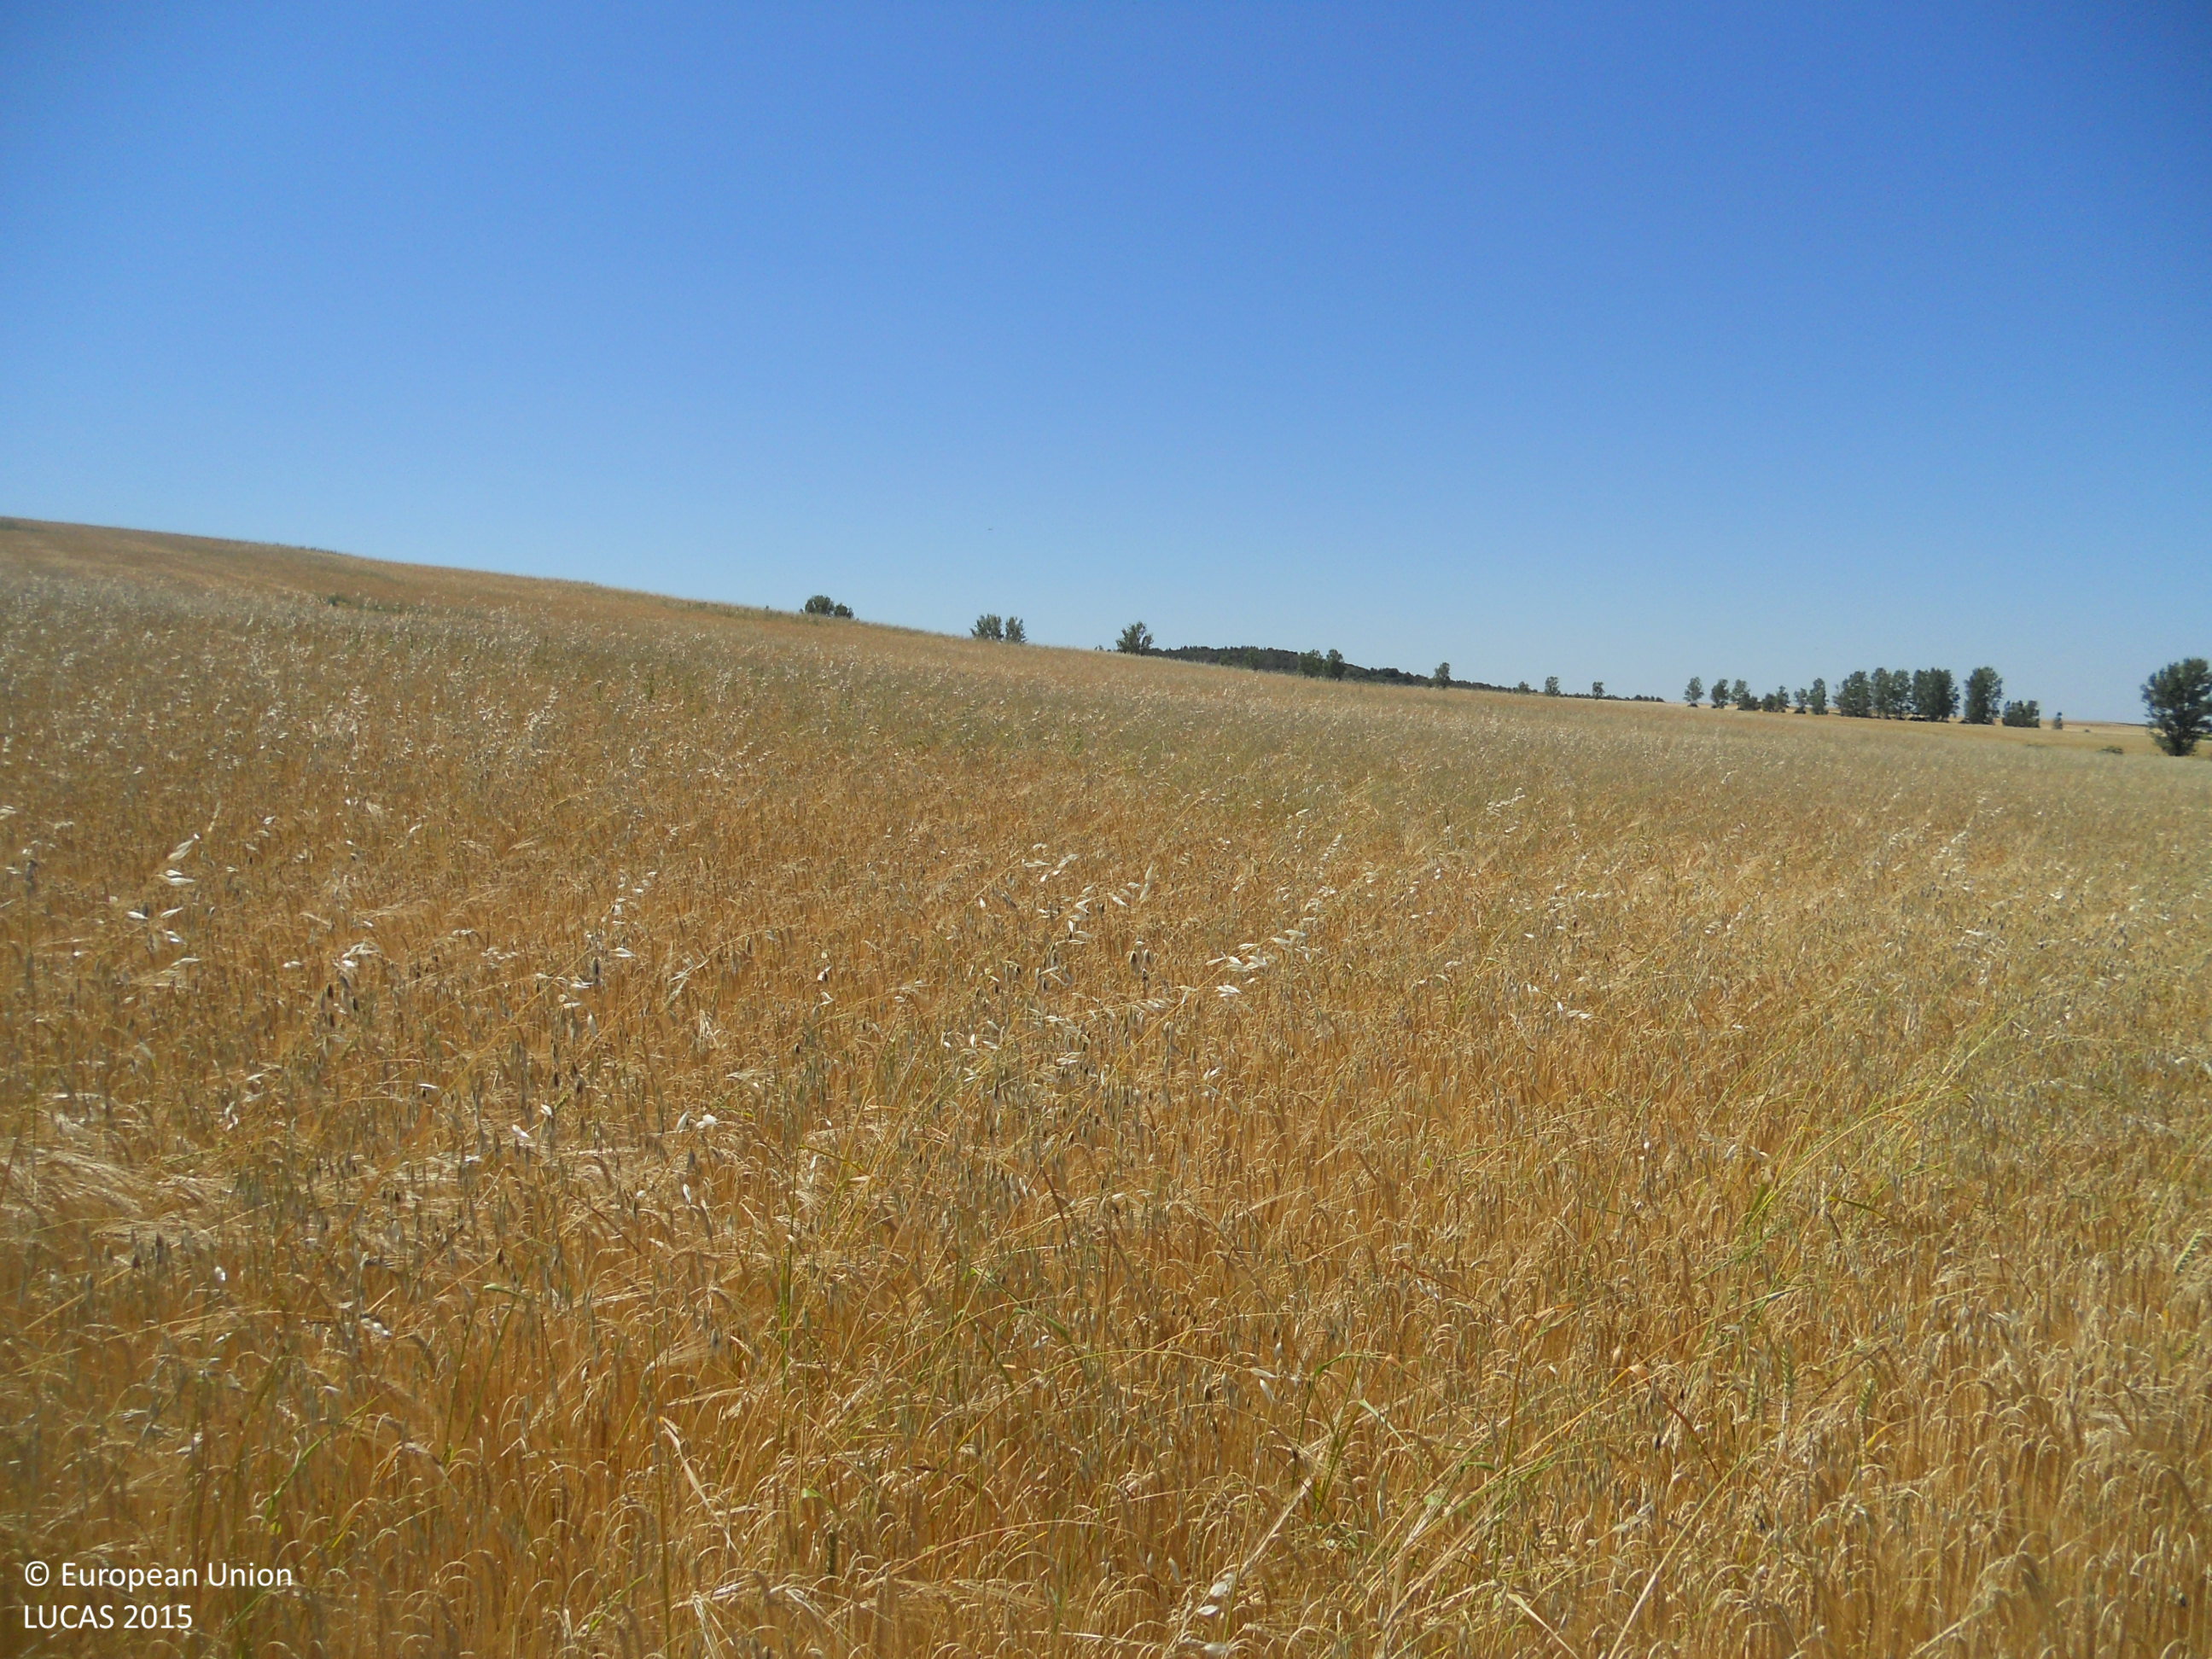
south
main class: Cropland
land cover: Barley
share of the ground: > 75 %
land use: Agriculture (excluding fallow land and kitchen gardens)
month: June
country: ES
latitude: 42.4145
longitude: -4.9691
